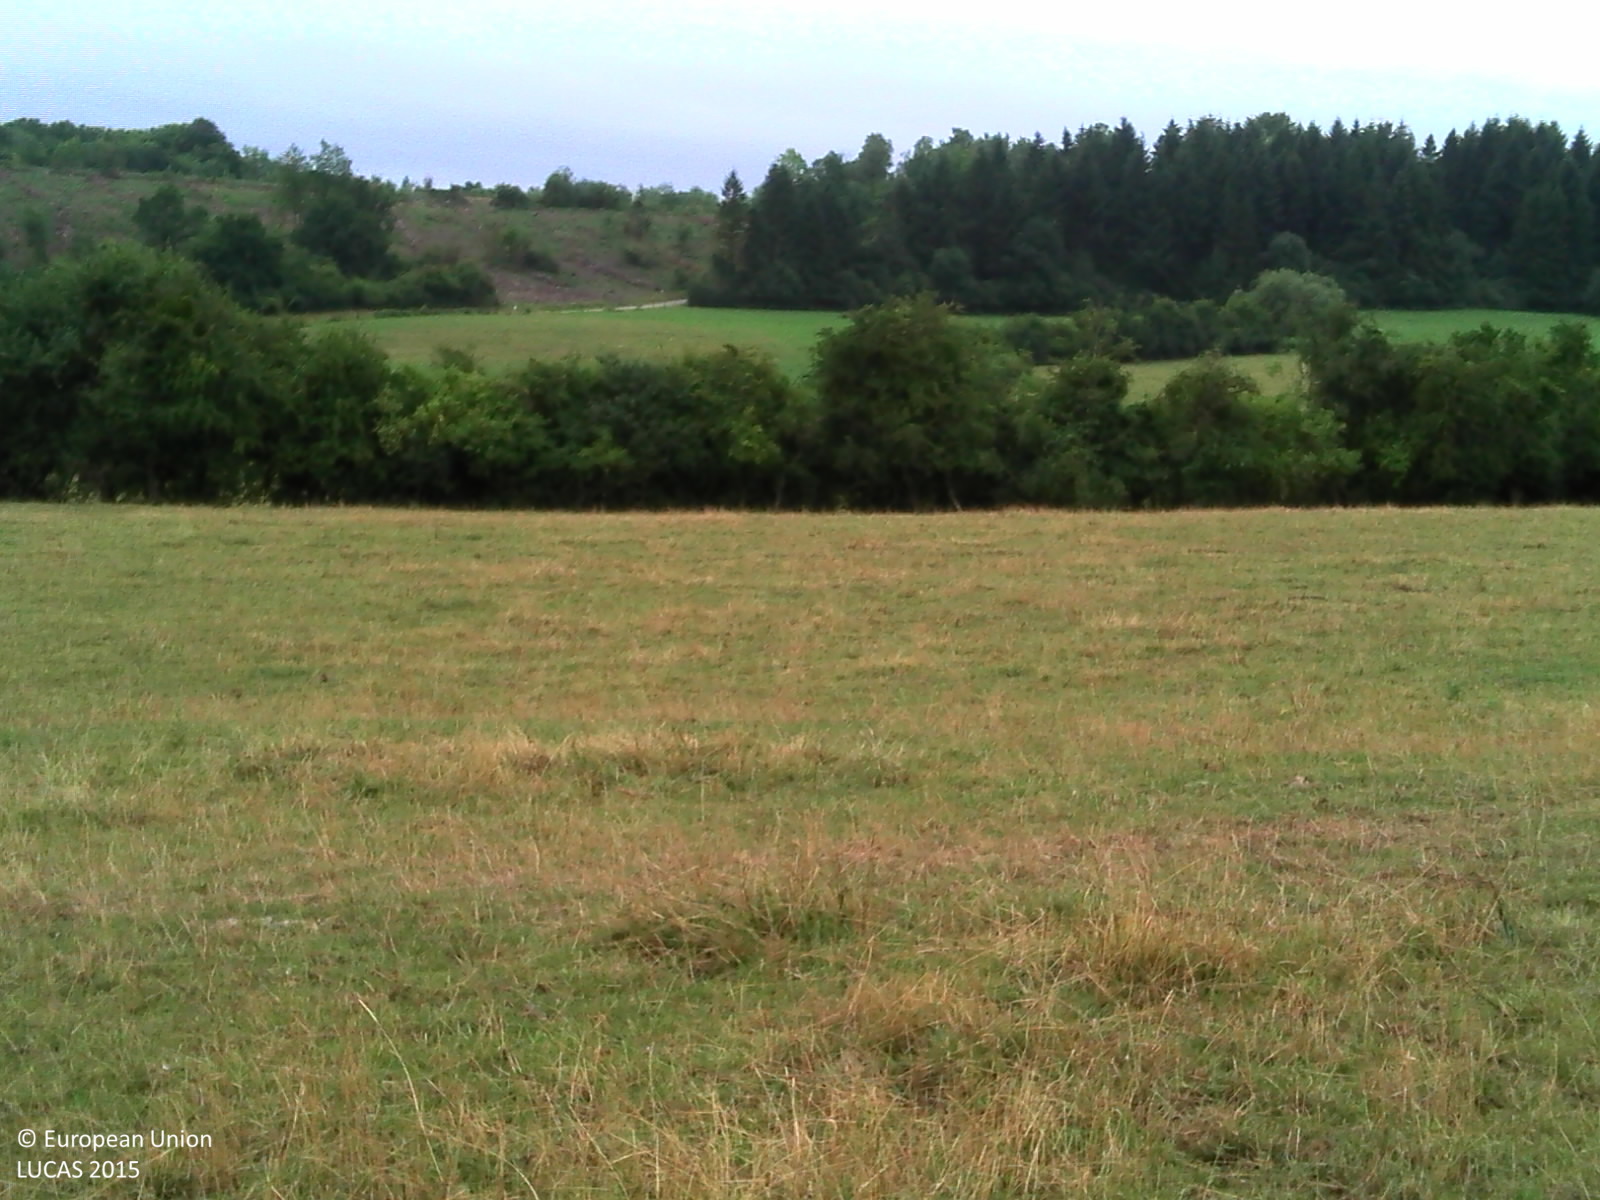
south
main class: Grassland
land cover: Grassland without tree/shrub cover
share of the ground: > 75 %
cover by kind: herbaceous plants 100 %
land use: Agriculture (excluding fallow land and kitchen gardens)
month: July
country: BE
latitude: 50.1840
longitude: 4.6325
